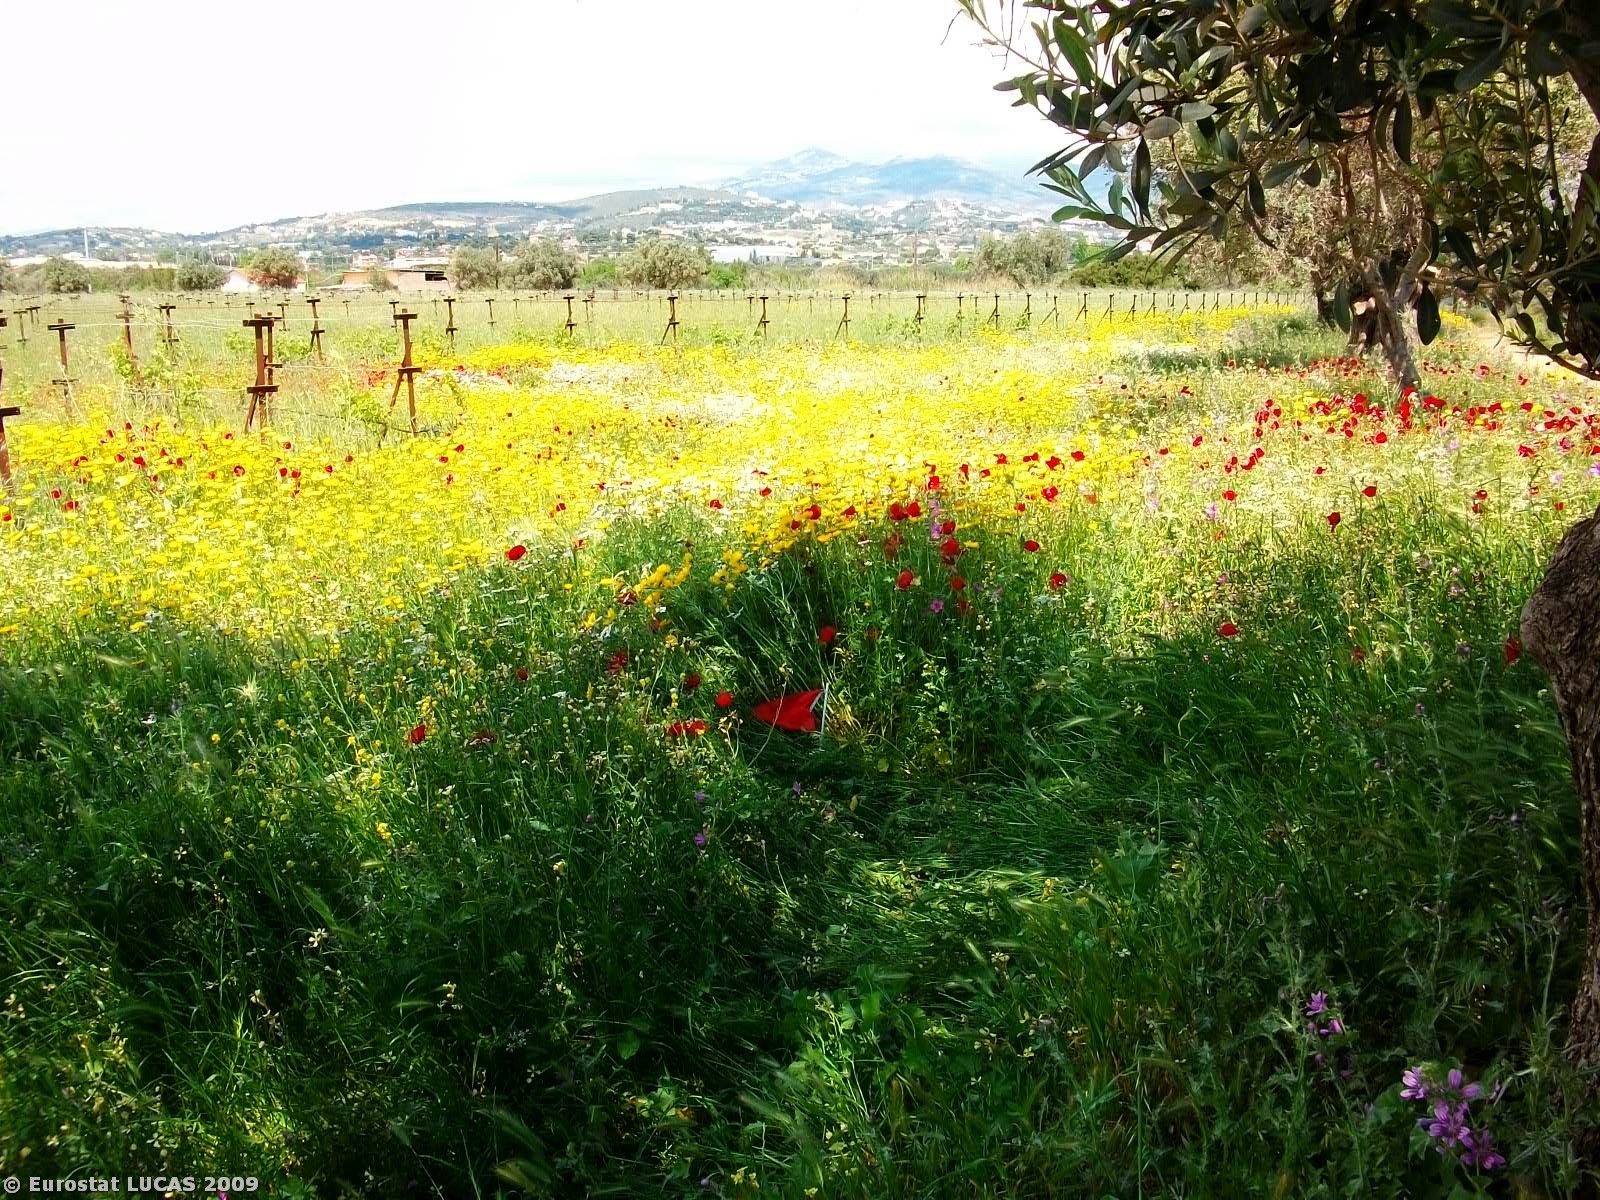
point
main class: Grassland
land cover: Grassland without tree/shrub cover
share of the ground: > 75 %
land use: Unused
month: May
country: GR
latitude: 37.9874
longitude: 23.9076
